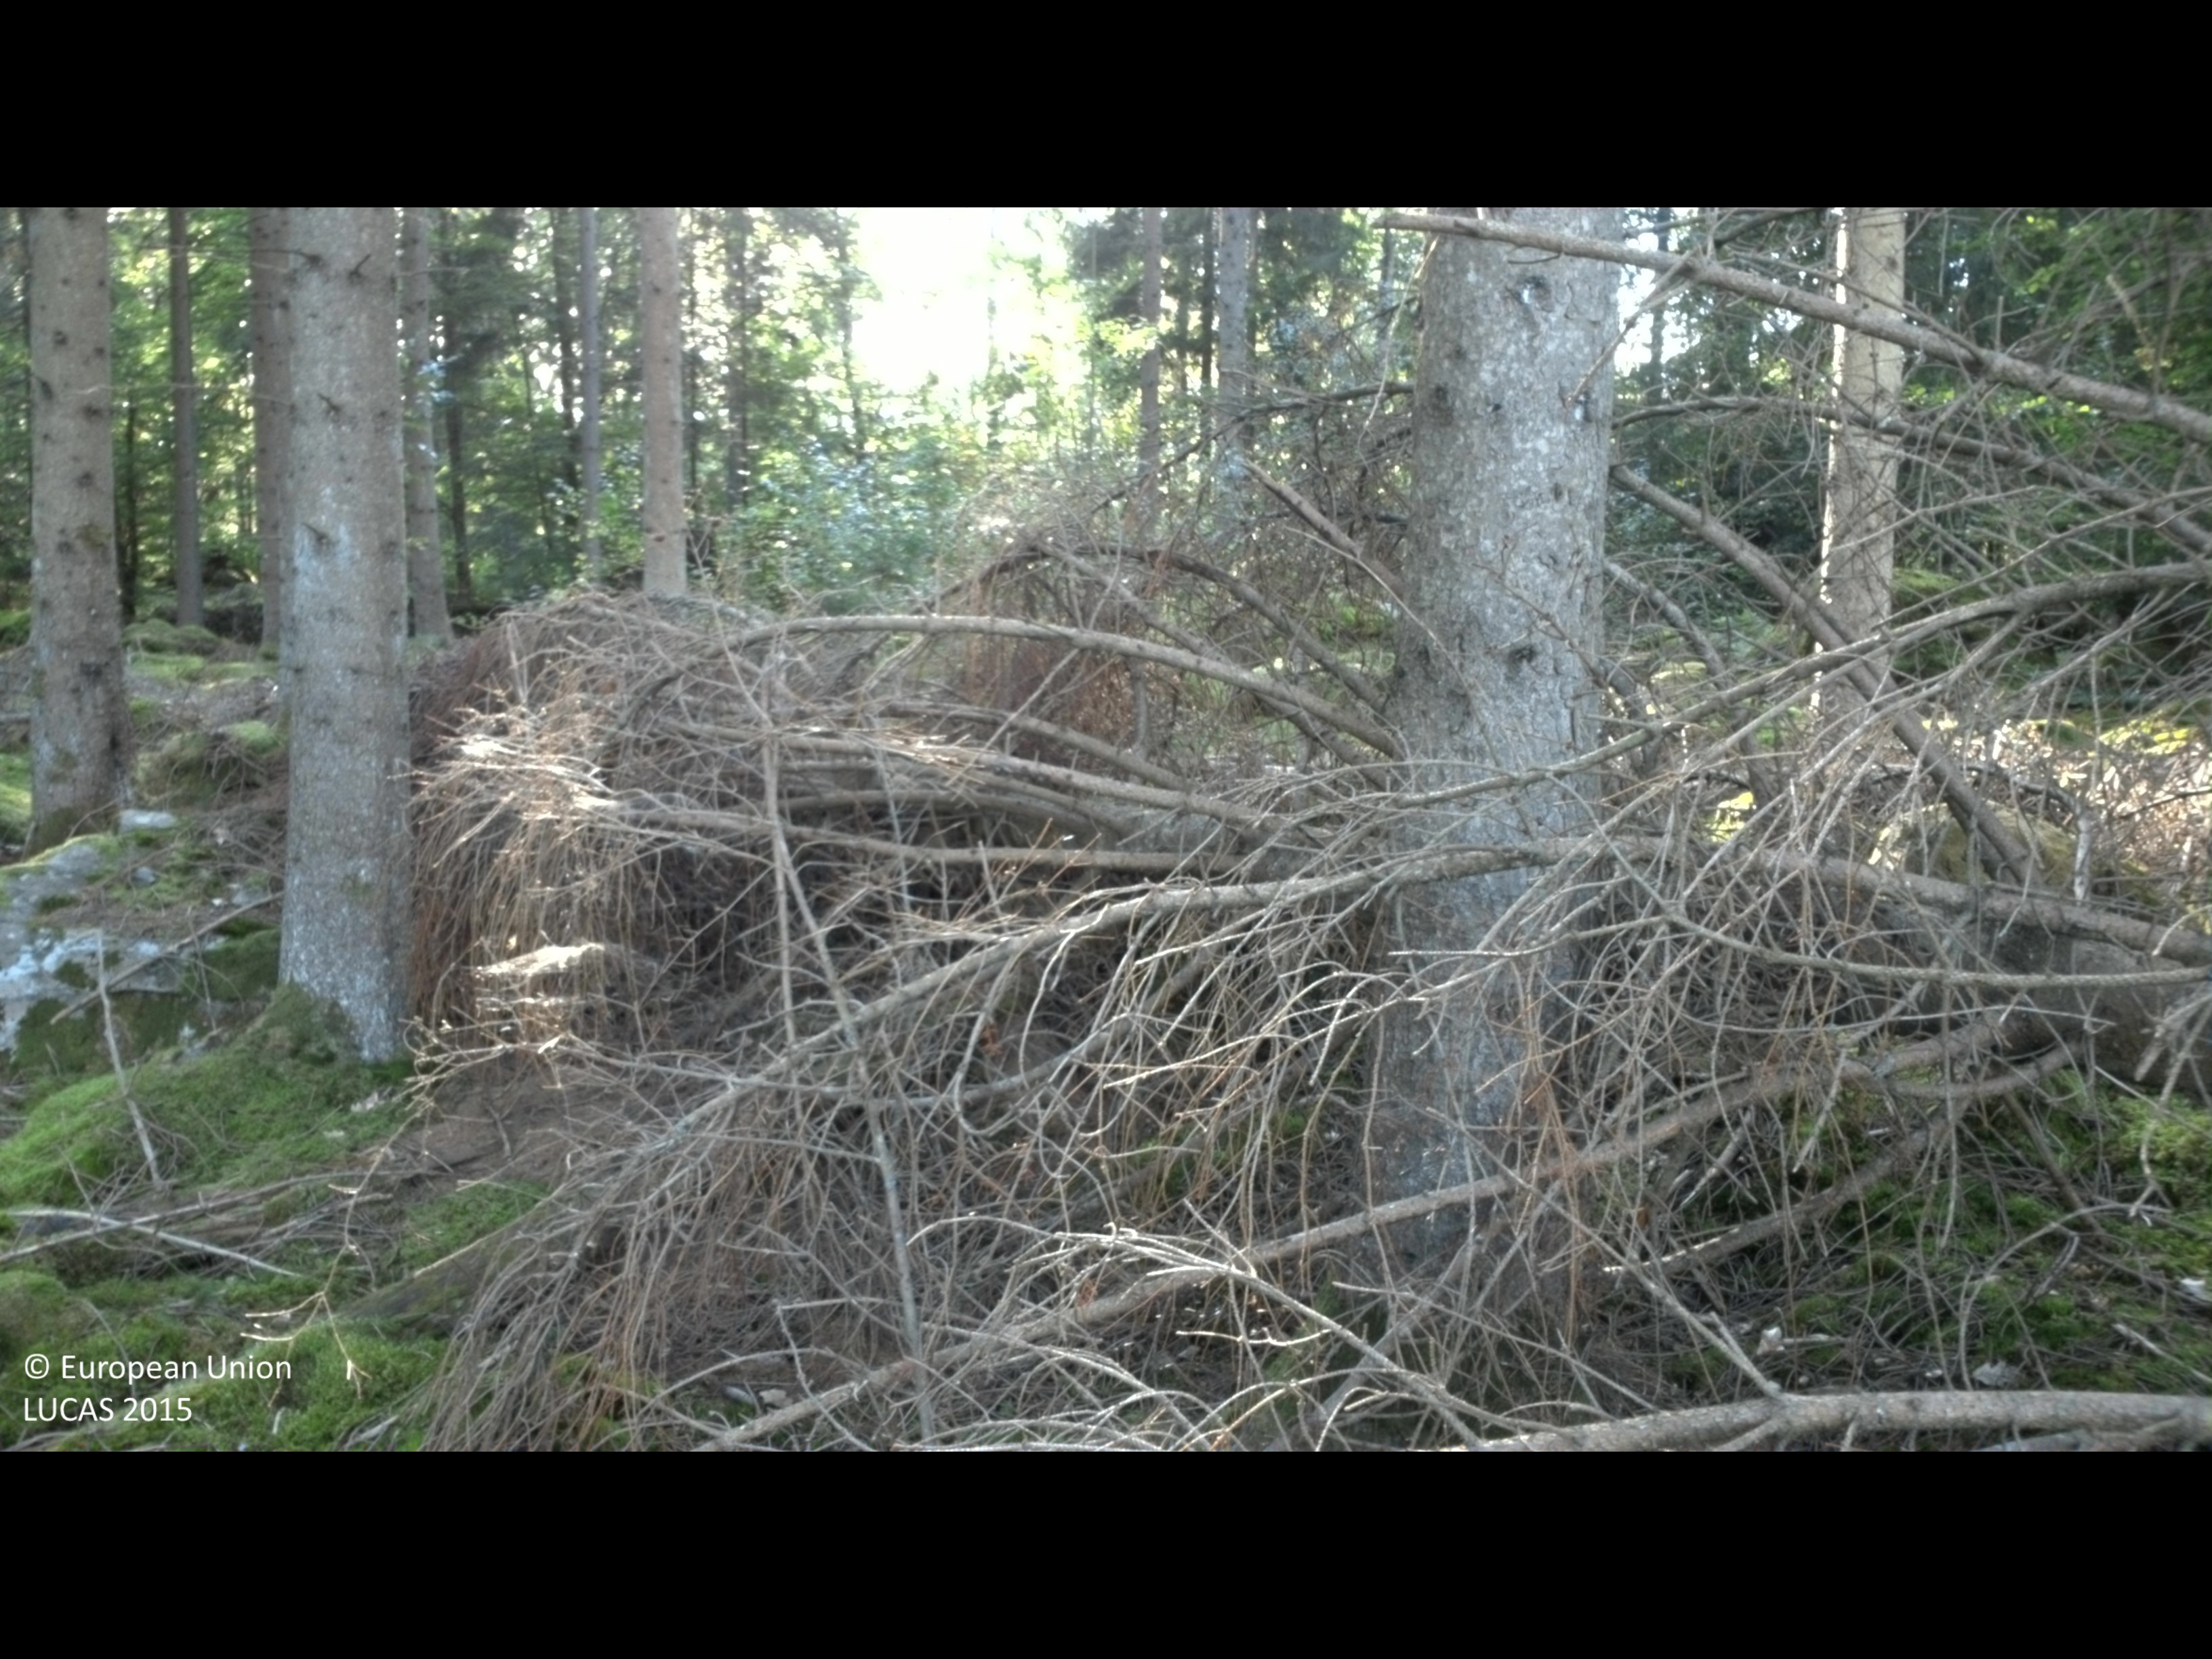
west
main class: Woodland
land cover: Spruce dominated coniferous woodland
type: boreal forest
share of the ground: 50 - 75 %
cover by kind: coniferous forest trees 70 %, lichens and mosses 30 %
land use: Forestry
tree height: > 5 m
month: August
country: SE
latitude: 56.3258
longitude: 14.4772
